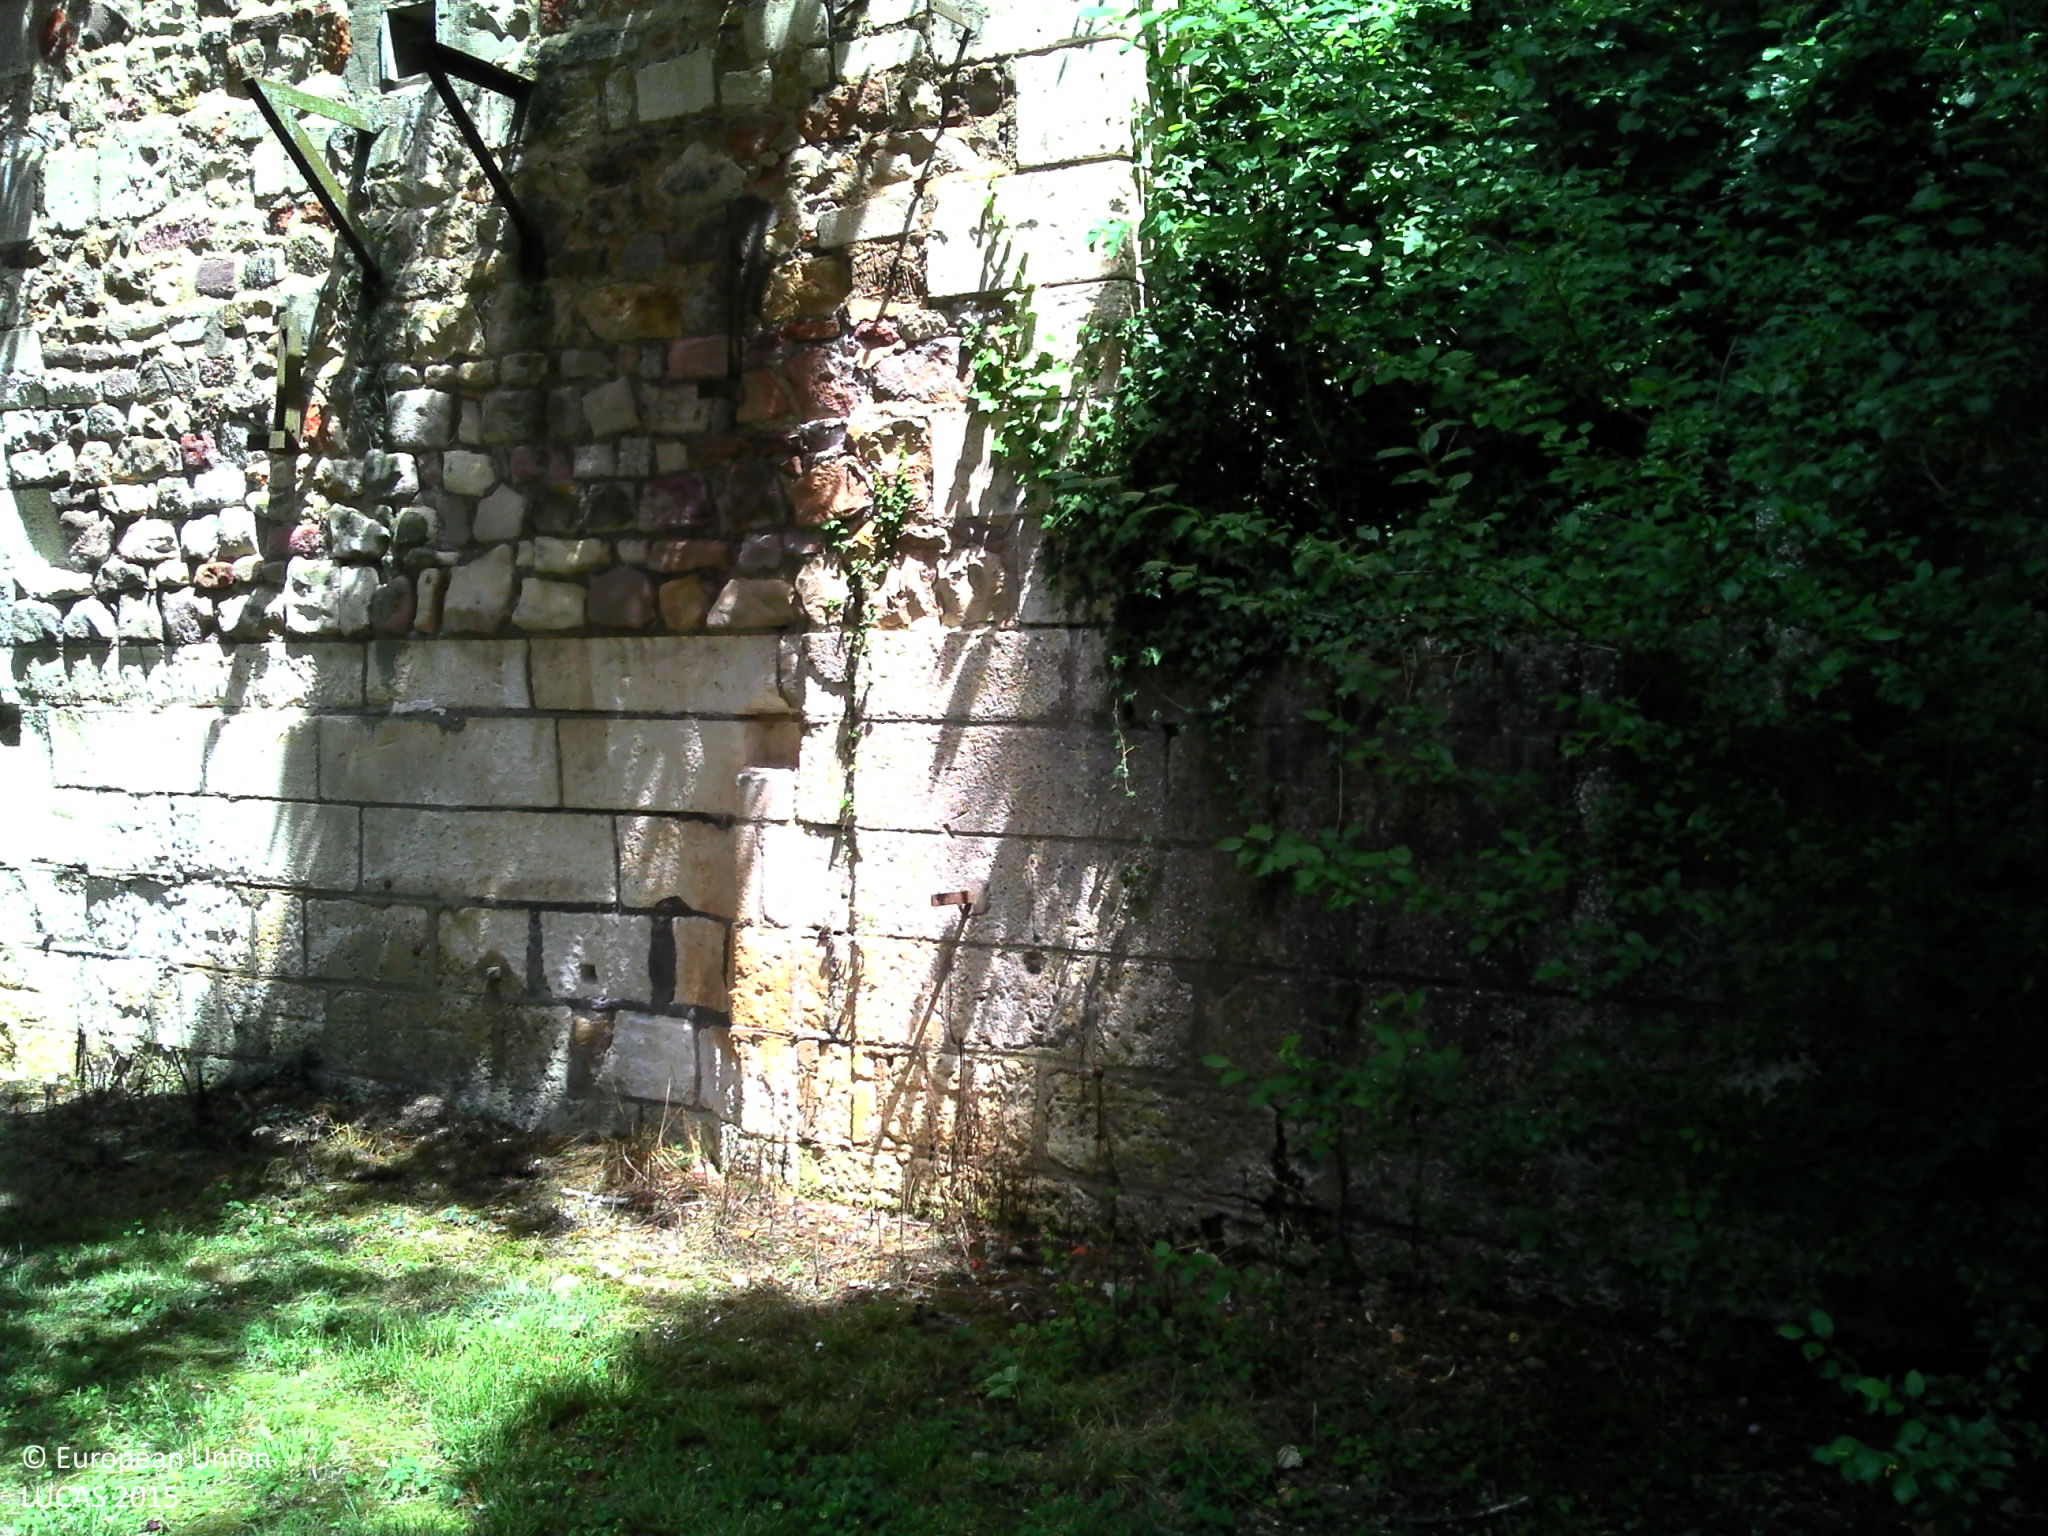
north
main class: Grassland
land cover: Grassland with sparse tree/shrub cover
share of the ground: > 75 %
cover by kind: herbaceous plants 95 %, broadleaved forest trees 5 %
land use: Amenities, museums, leisure
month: June
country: FR
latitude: 45.7738
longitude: 0.4042
